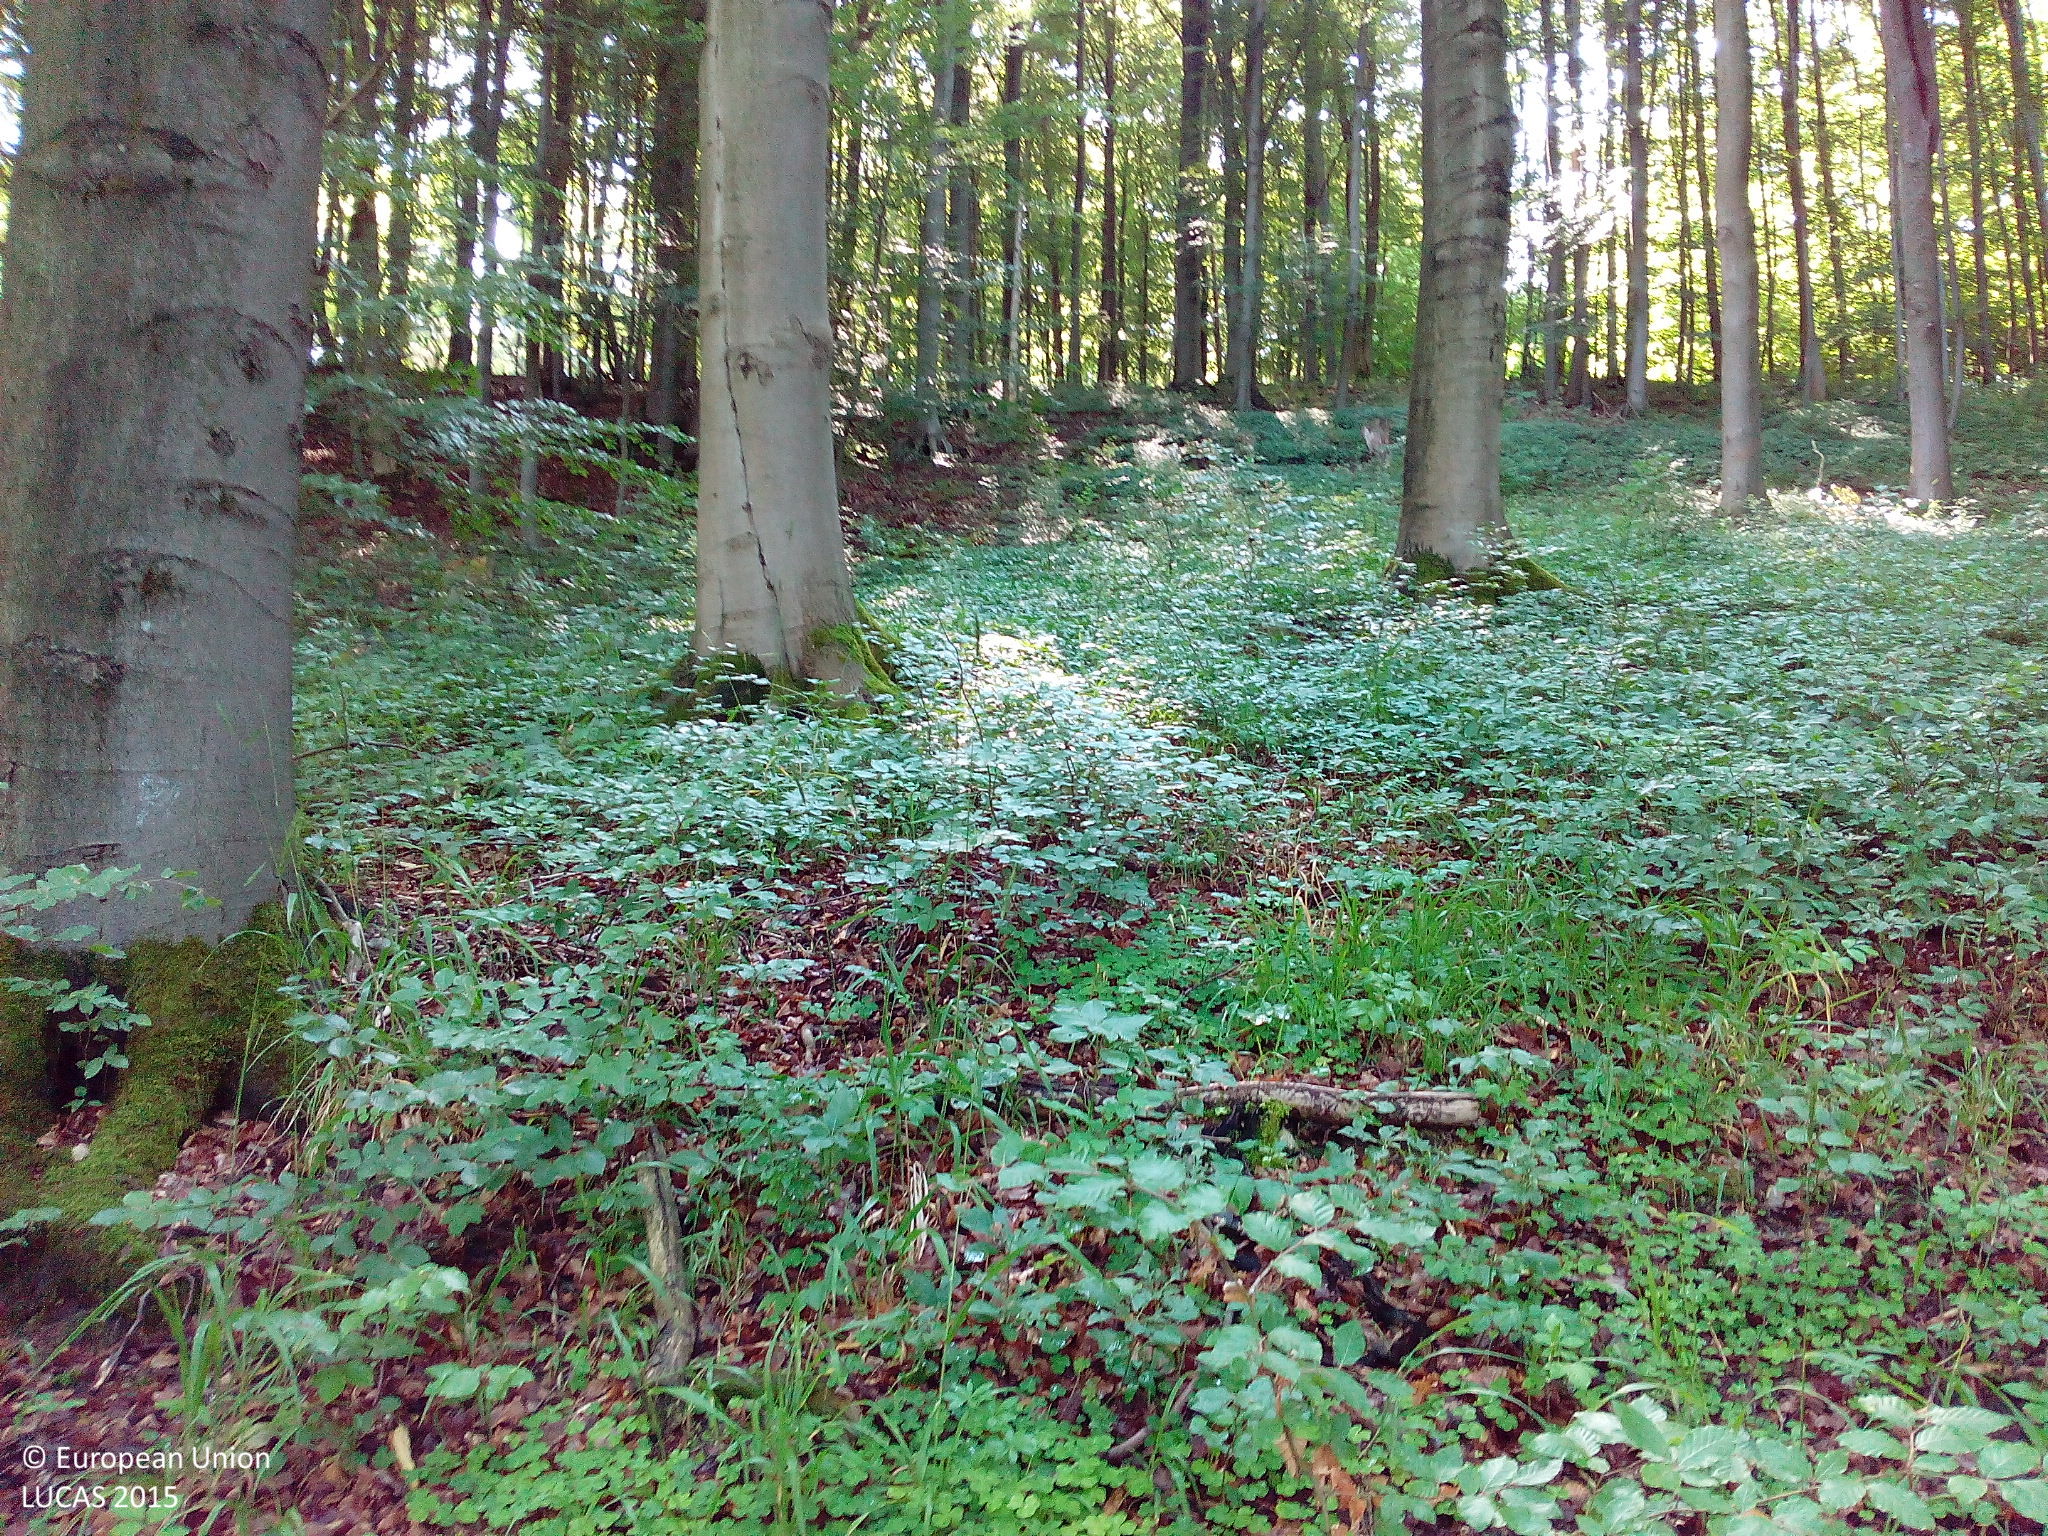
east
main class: Woodland
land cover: Broadleaved woodland
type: beech forest
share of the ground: > 75 %
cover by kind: broadleaved forest trees 100 %
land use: Forestry
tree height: > 5 m
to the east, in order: Broadleaved woodland
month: July
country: DE
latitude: 50.6337
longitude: 9.9293
